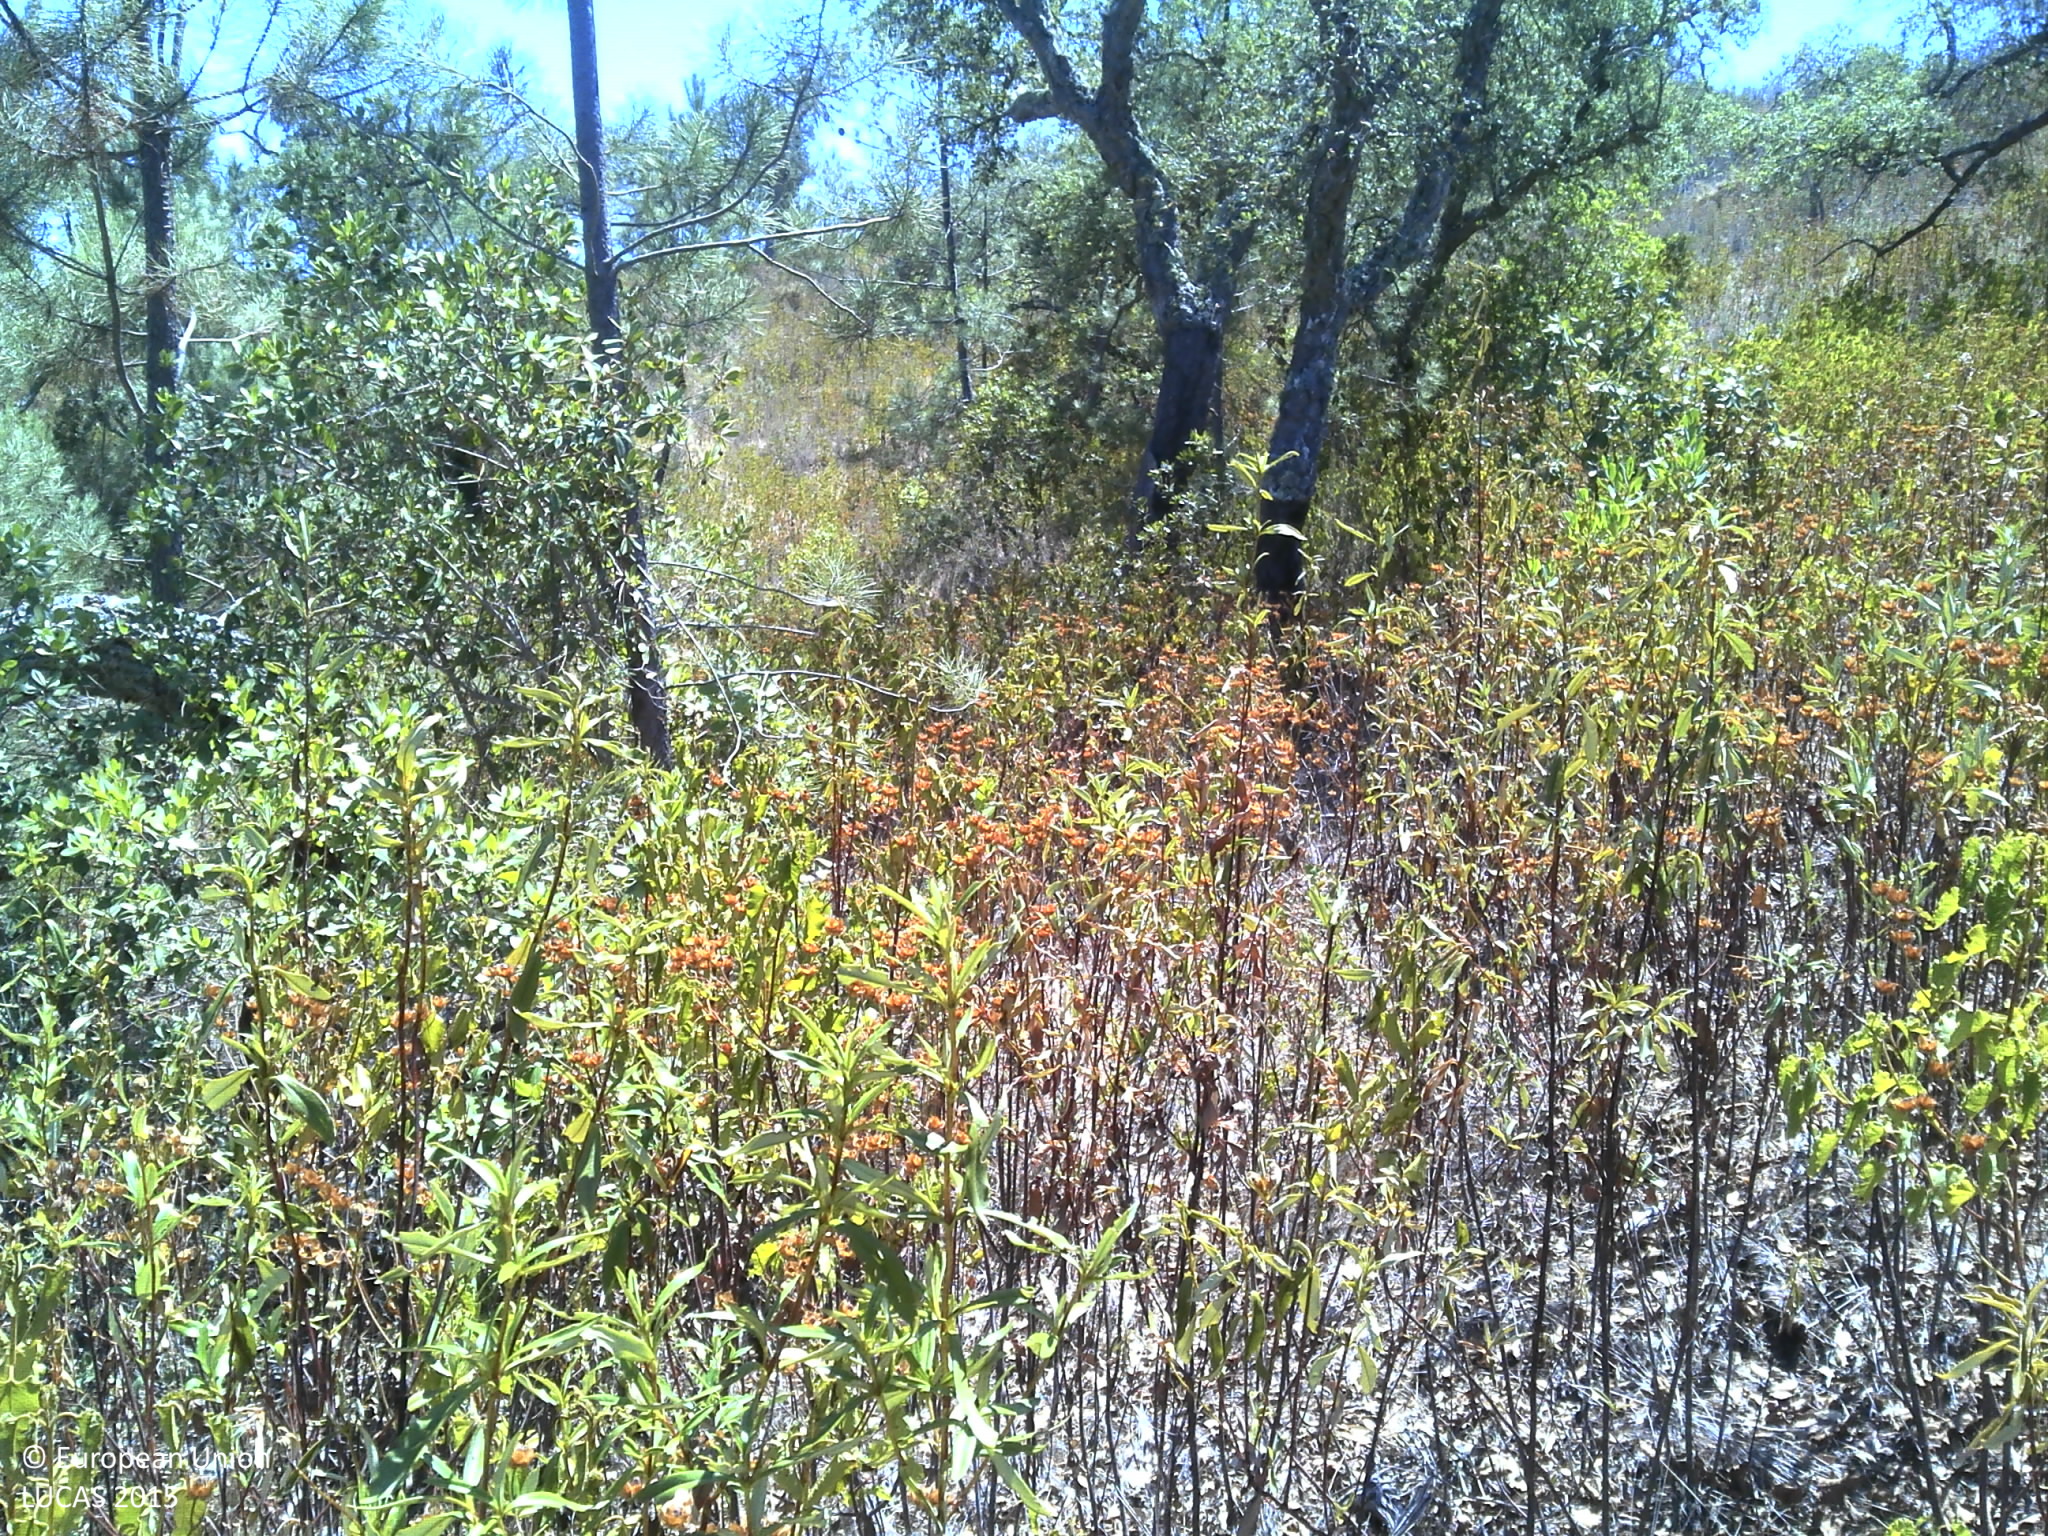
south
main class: Woodland
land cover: Broadleaved woodland
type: broadleaved evergreen forest
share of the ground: 10 - 25 %
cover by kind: unconsolidated bare surface 40 %, broadleaved forest trees 25 %, shrubs 25 %, herbaceous plants 10 %
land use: Forestry
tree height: > 5 m
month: July
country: PT
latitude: 38.2415
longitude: -7.7739
